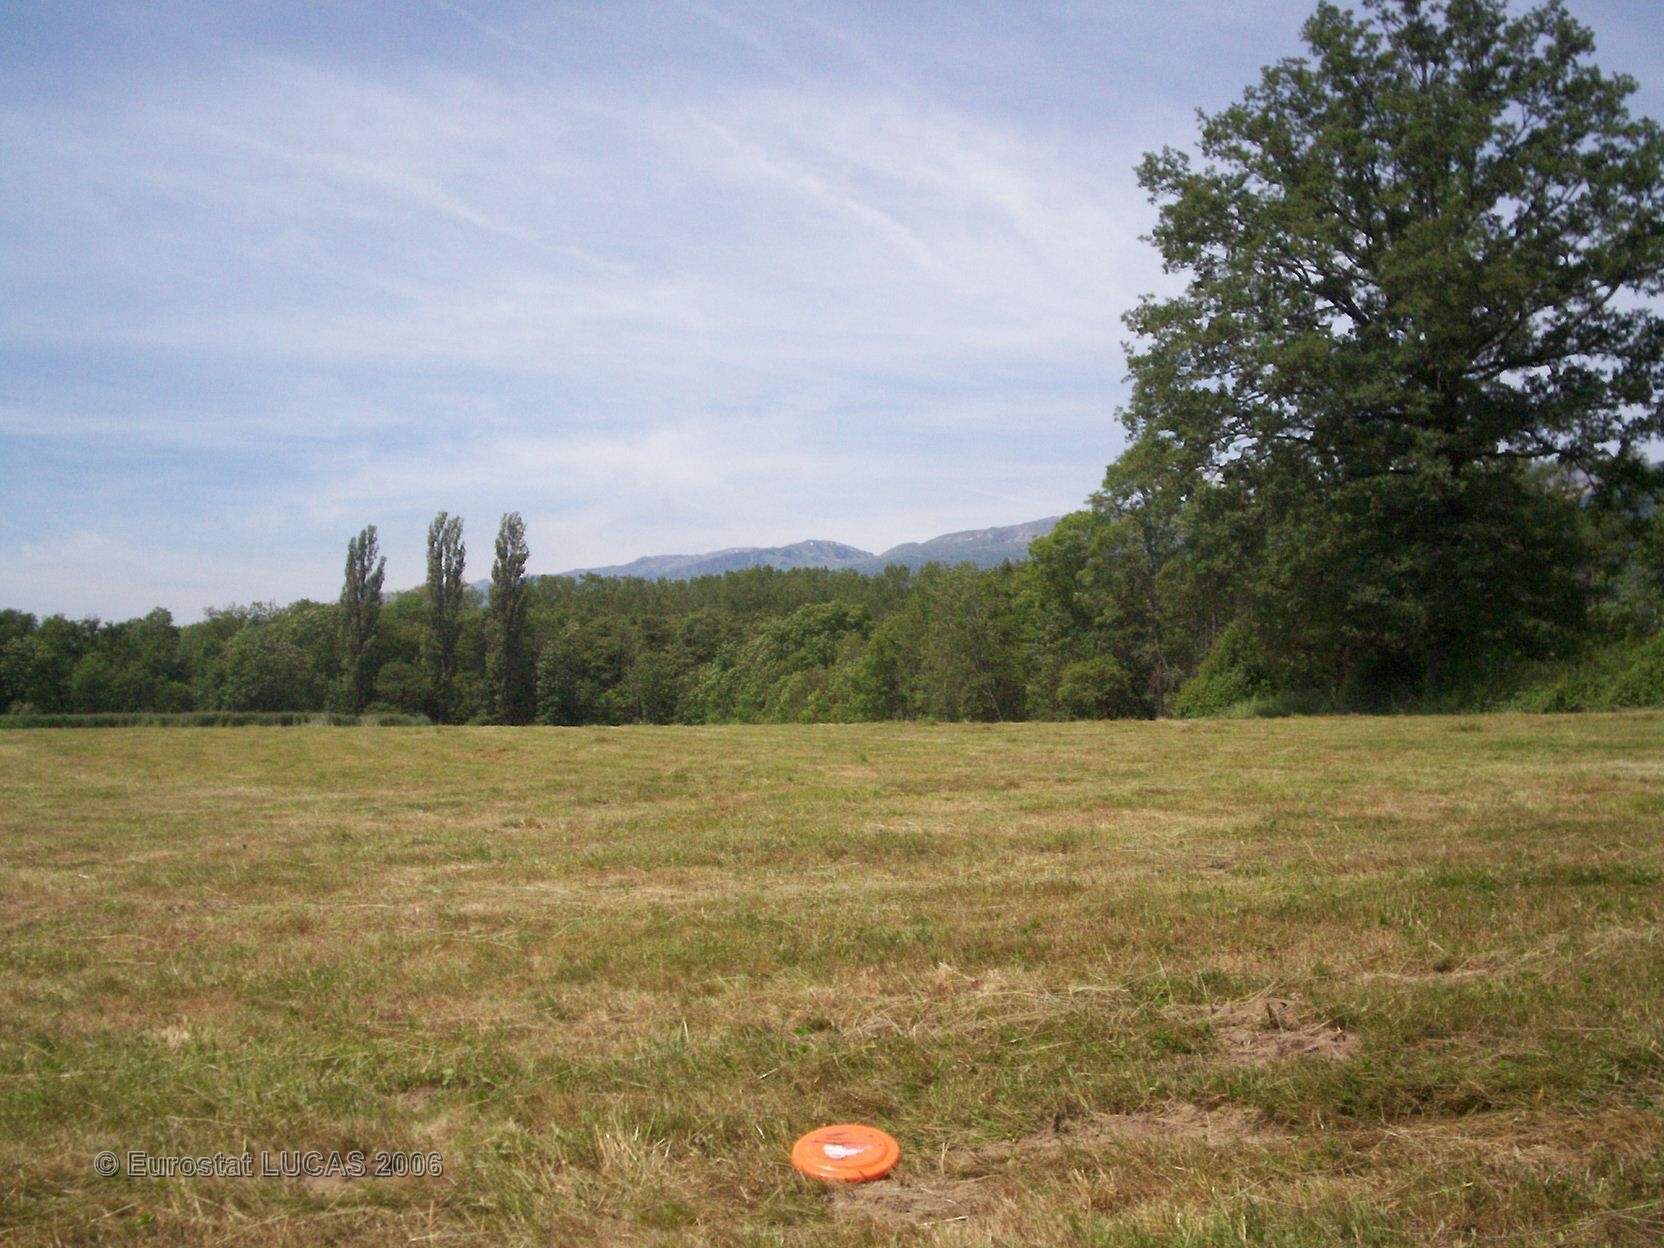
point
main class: Grassland
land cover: Grassland without tree/shrub cover
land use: Agriculture (excluding fallow land and kitchen gardens)
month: June
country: FR
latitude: 46.3160
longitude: 6.0943
